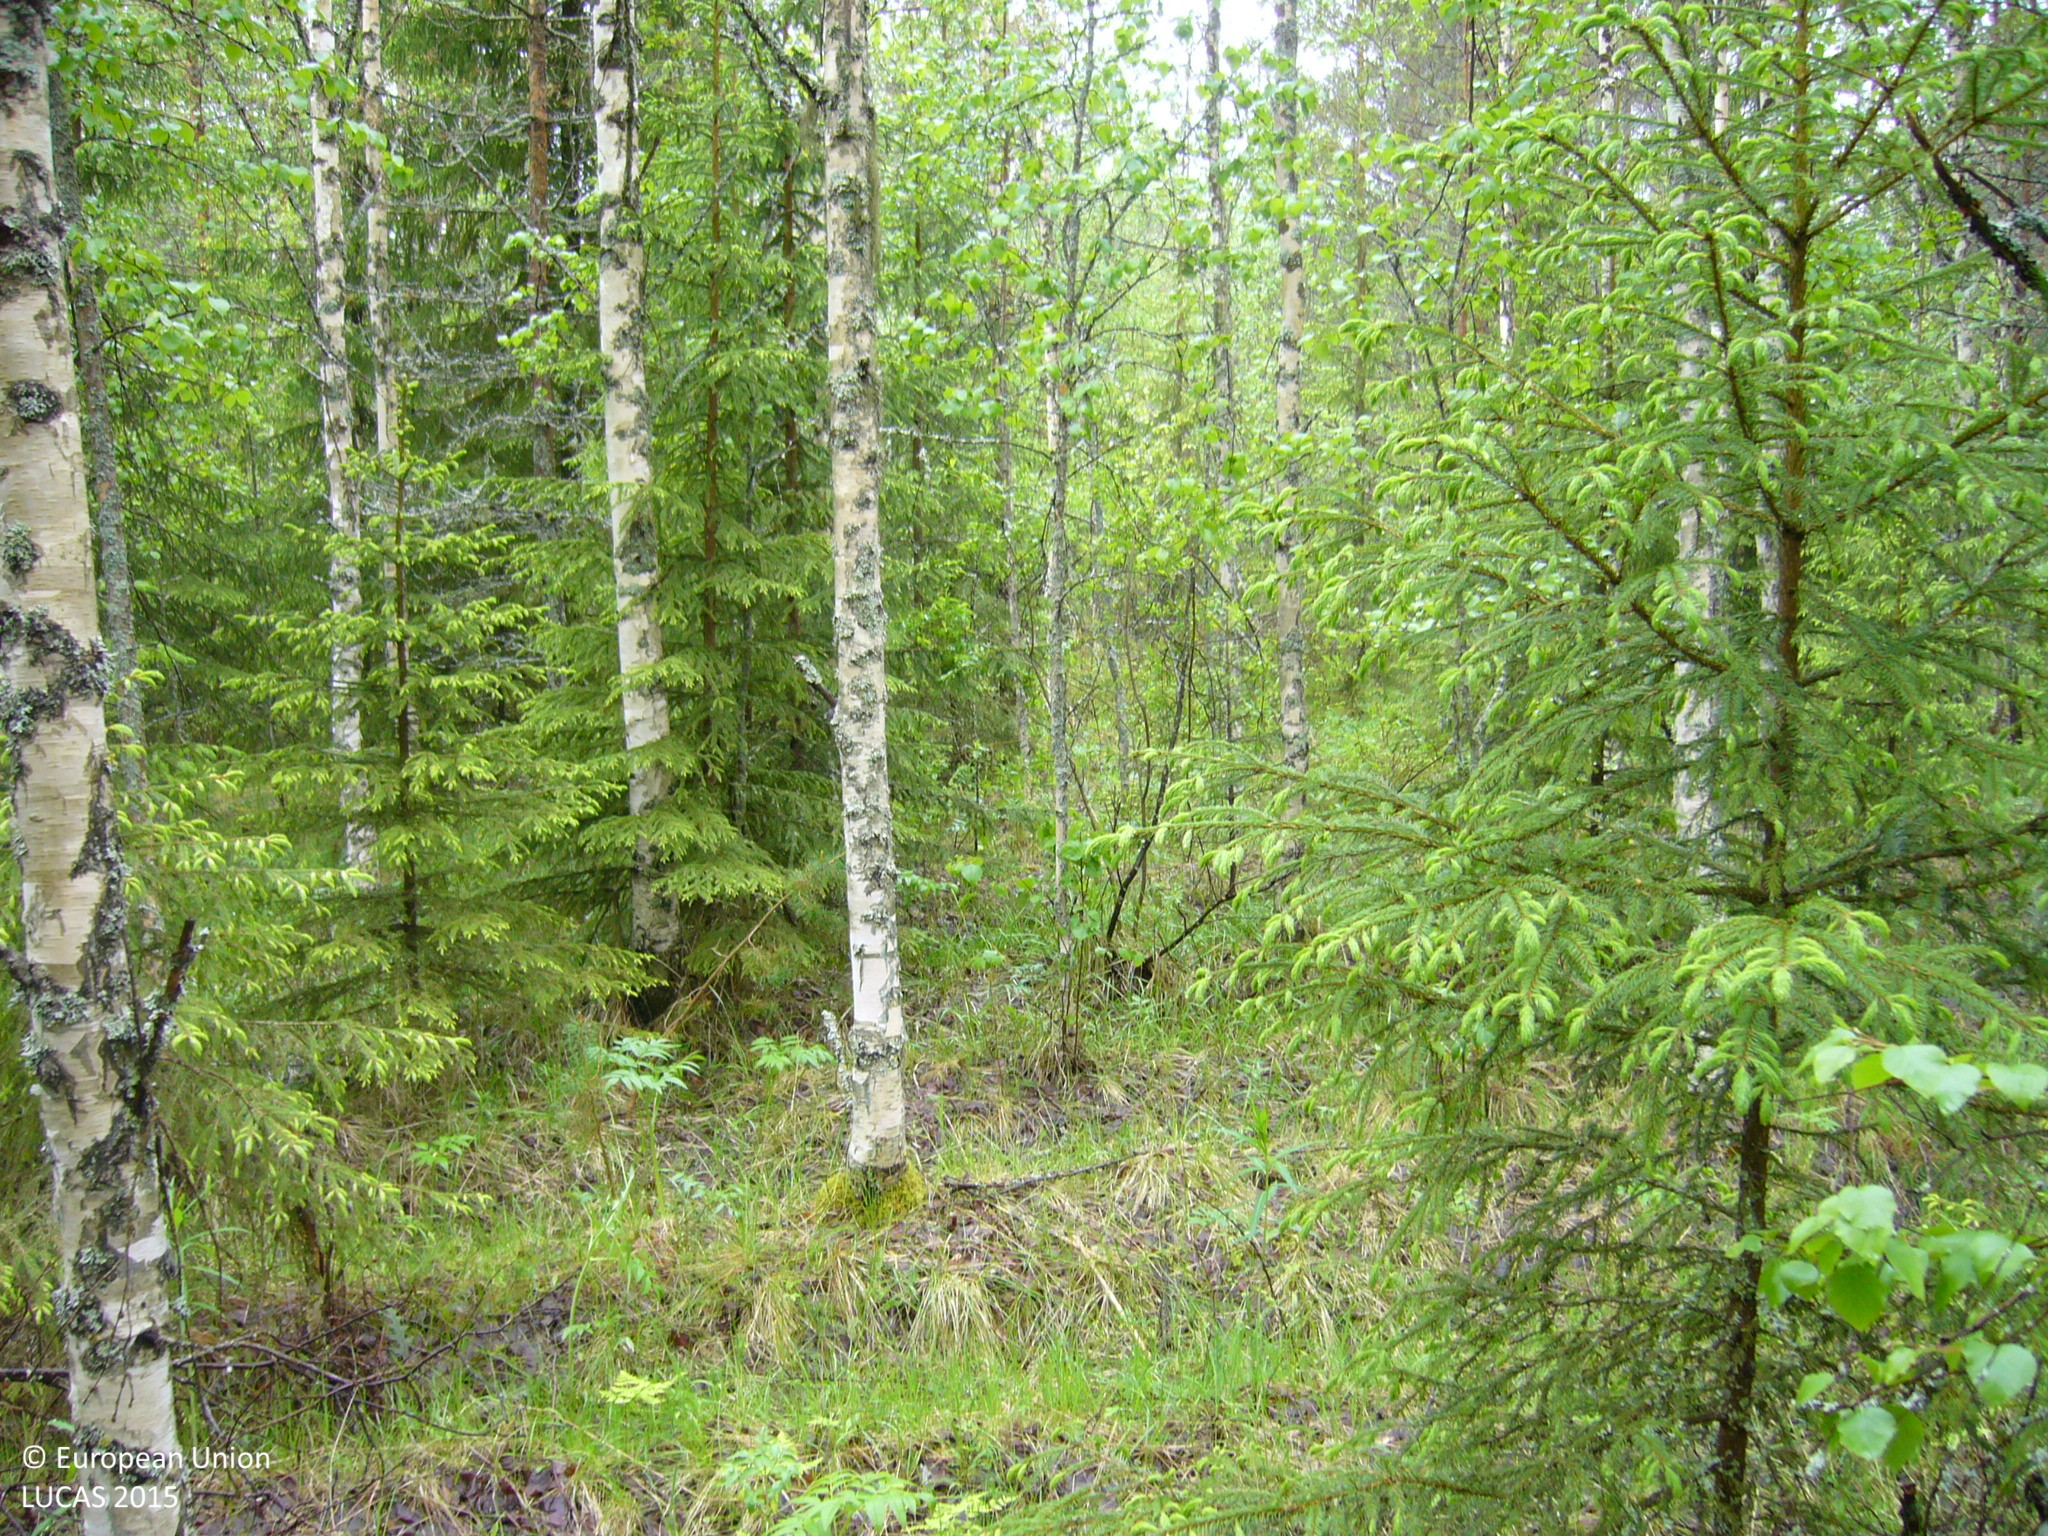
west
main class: Woodland
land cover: Spruce dominated mixed woodland
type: boreal forest
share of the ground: > 75 %
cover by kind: broadleaved forest trees 45 %, coniferous forest trees 30 %, herbaceous plants 25 %
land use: Forestry
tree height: > 5 m
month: June
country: FI
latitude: 63.7336
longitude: 26.9675
